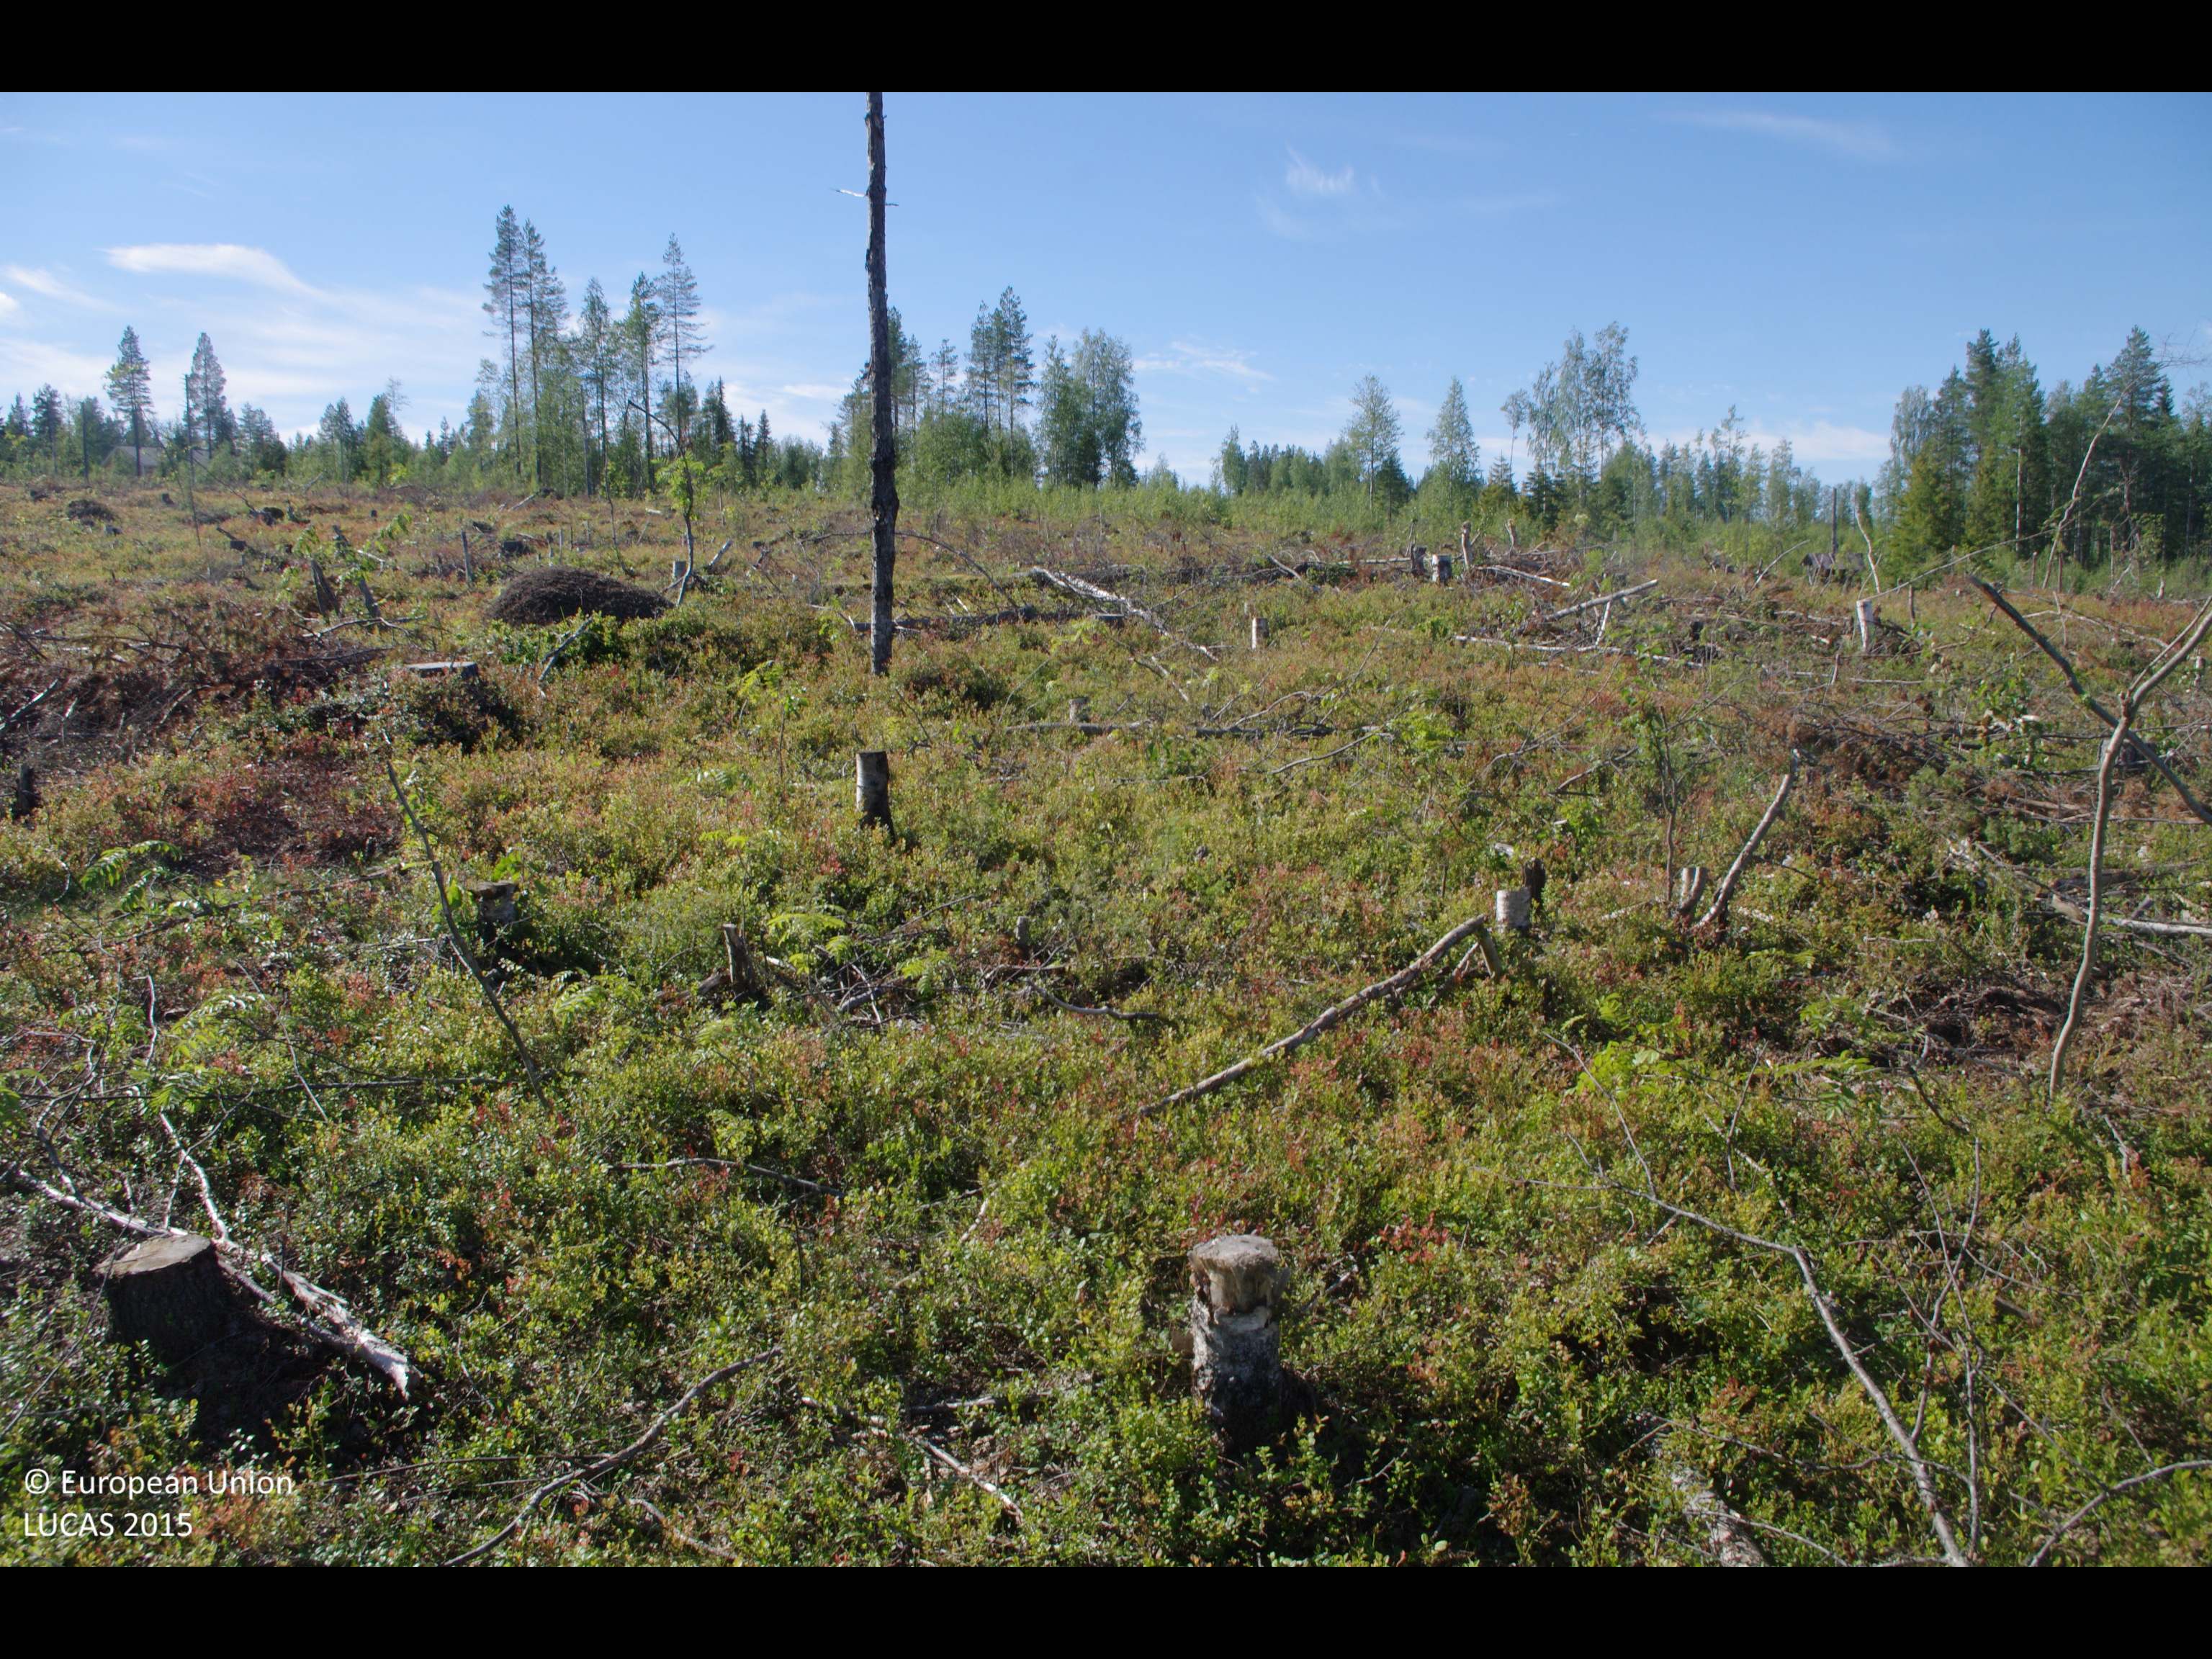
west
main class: Shrubland
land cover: Shrubland with sparse tree cover
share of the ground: > 75 %
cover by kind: shrubs 75 %, broadleaved forest trees 5 %, herbaceous plants 5 %, unconsolidated bare surface 5 %
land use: Forestry
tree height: < 5 m
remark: Clear cut
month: August
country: FI
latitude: 65.6197
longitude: 28.1011
